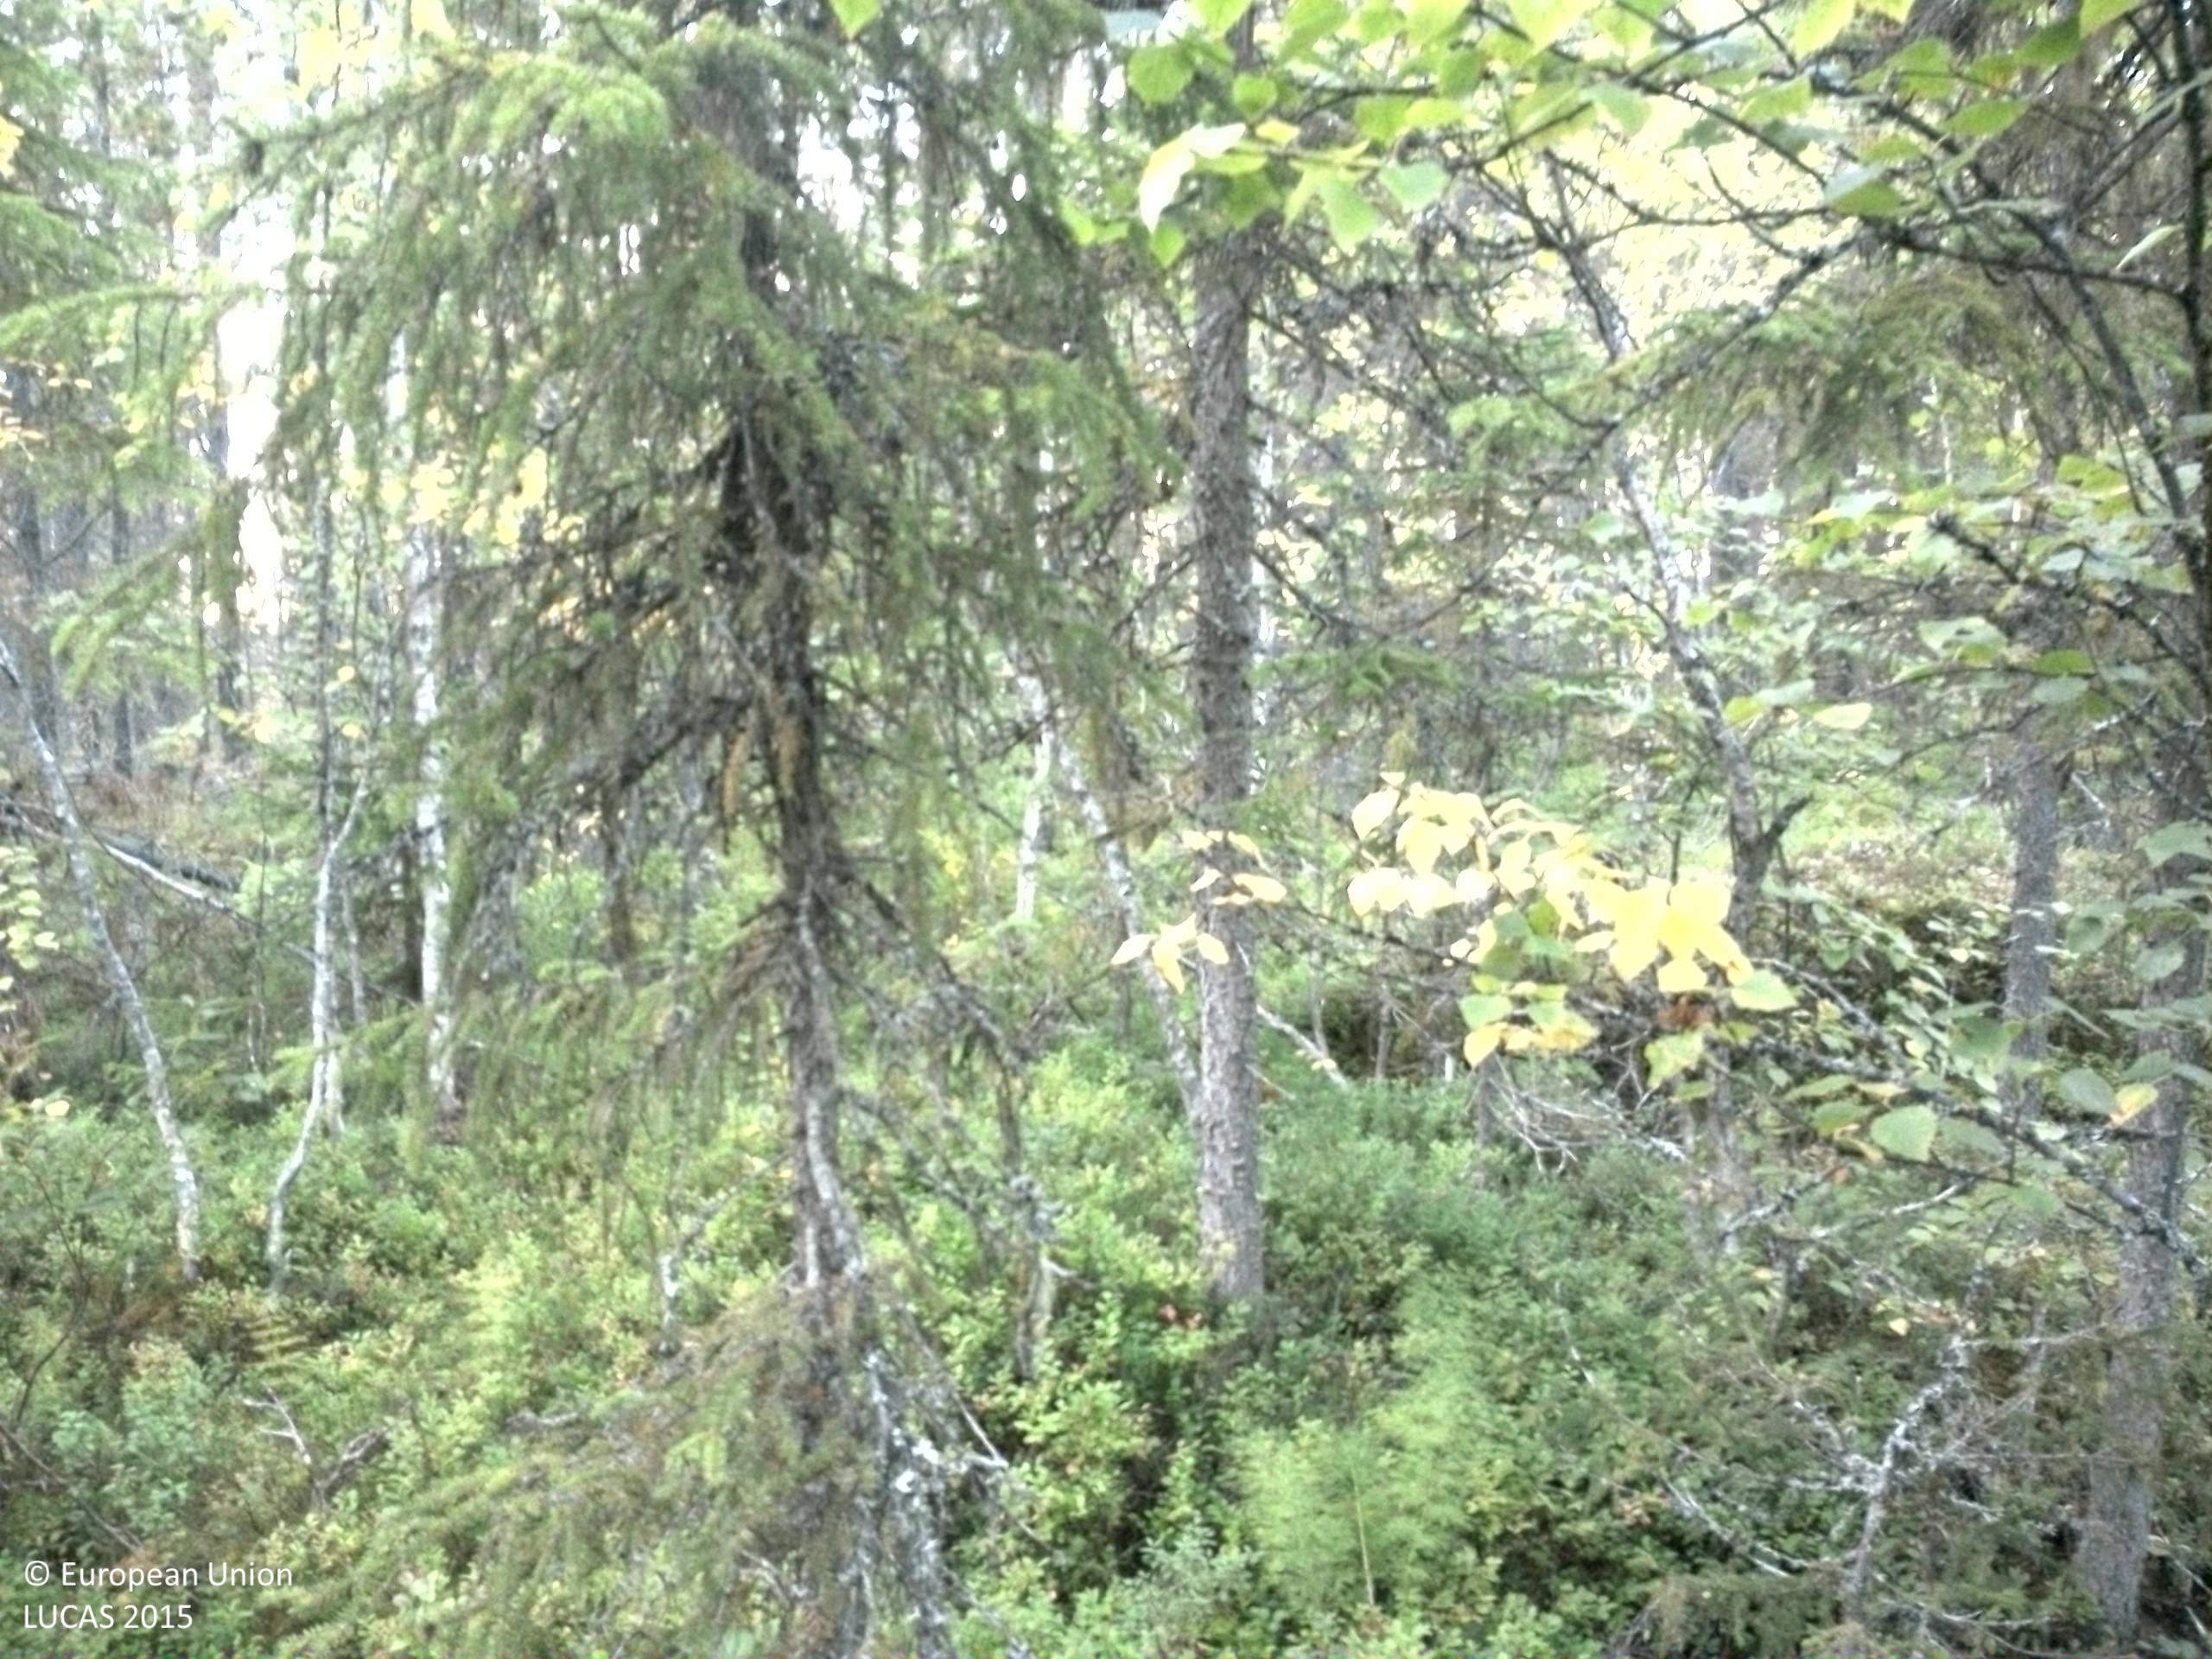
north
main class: Woodland
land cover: Other mixed woodland
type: boreal forest
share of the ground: 50 - 75 %
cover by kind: coniferous forest trees 45 %, shrubs 30 %, broadleaved forest trees 15 %, lichens and mosses 10 %
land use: Forestry
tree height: > 5 m
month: September
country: SE
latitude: 63.8953
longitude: 16.6730
